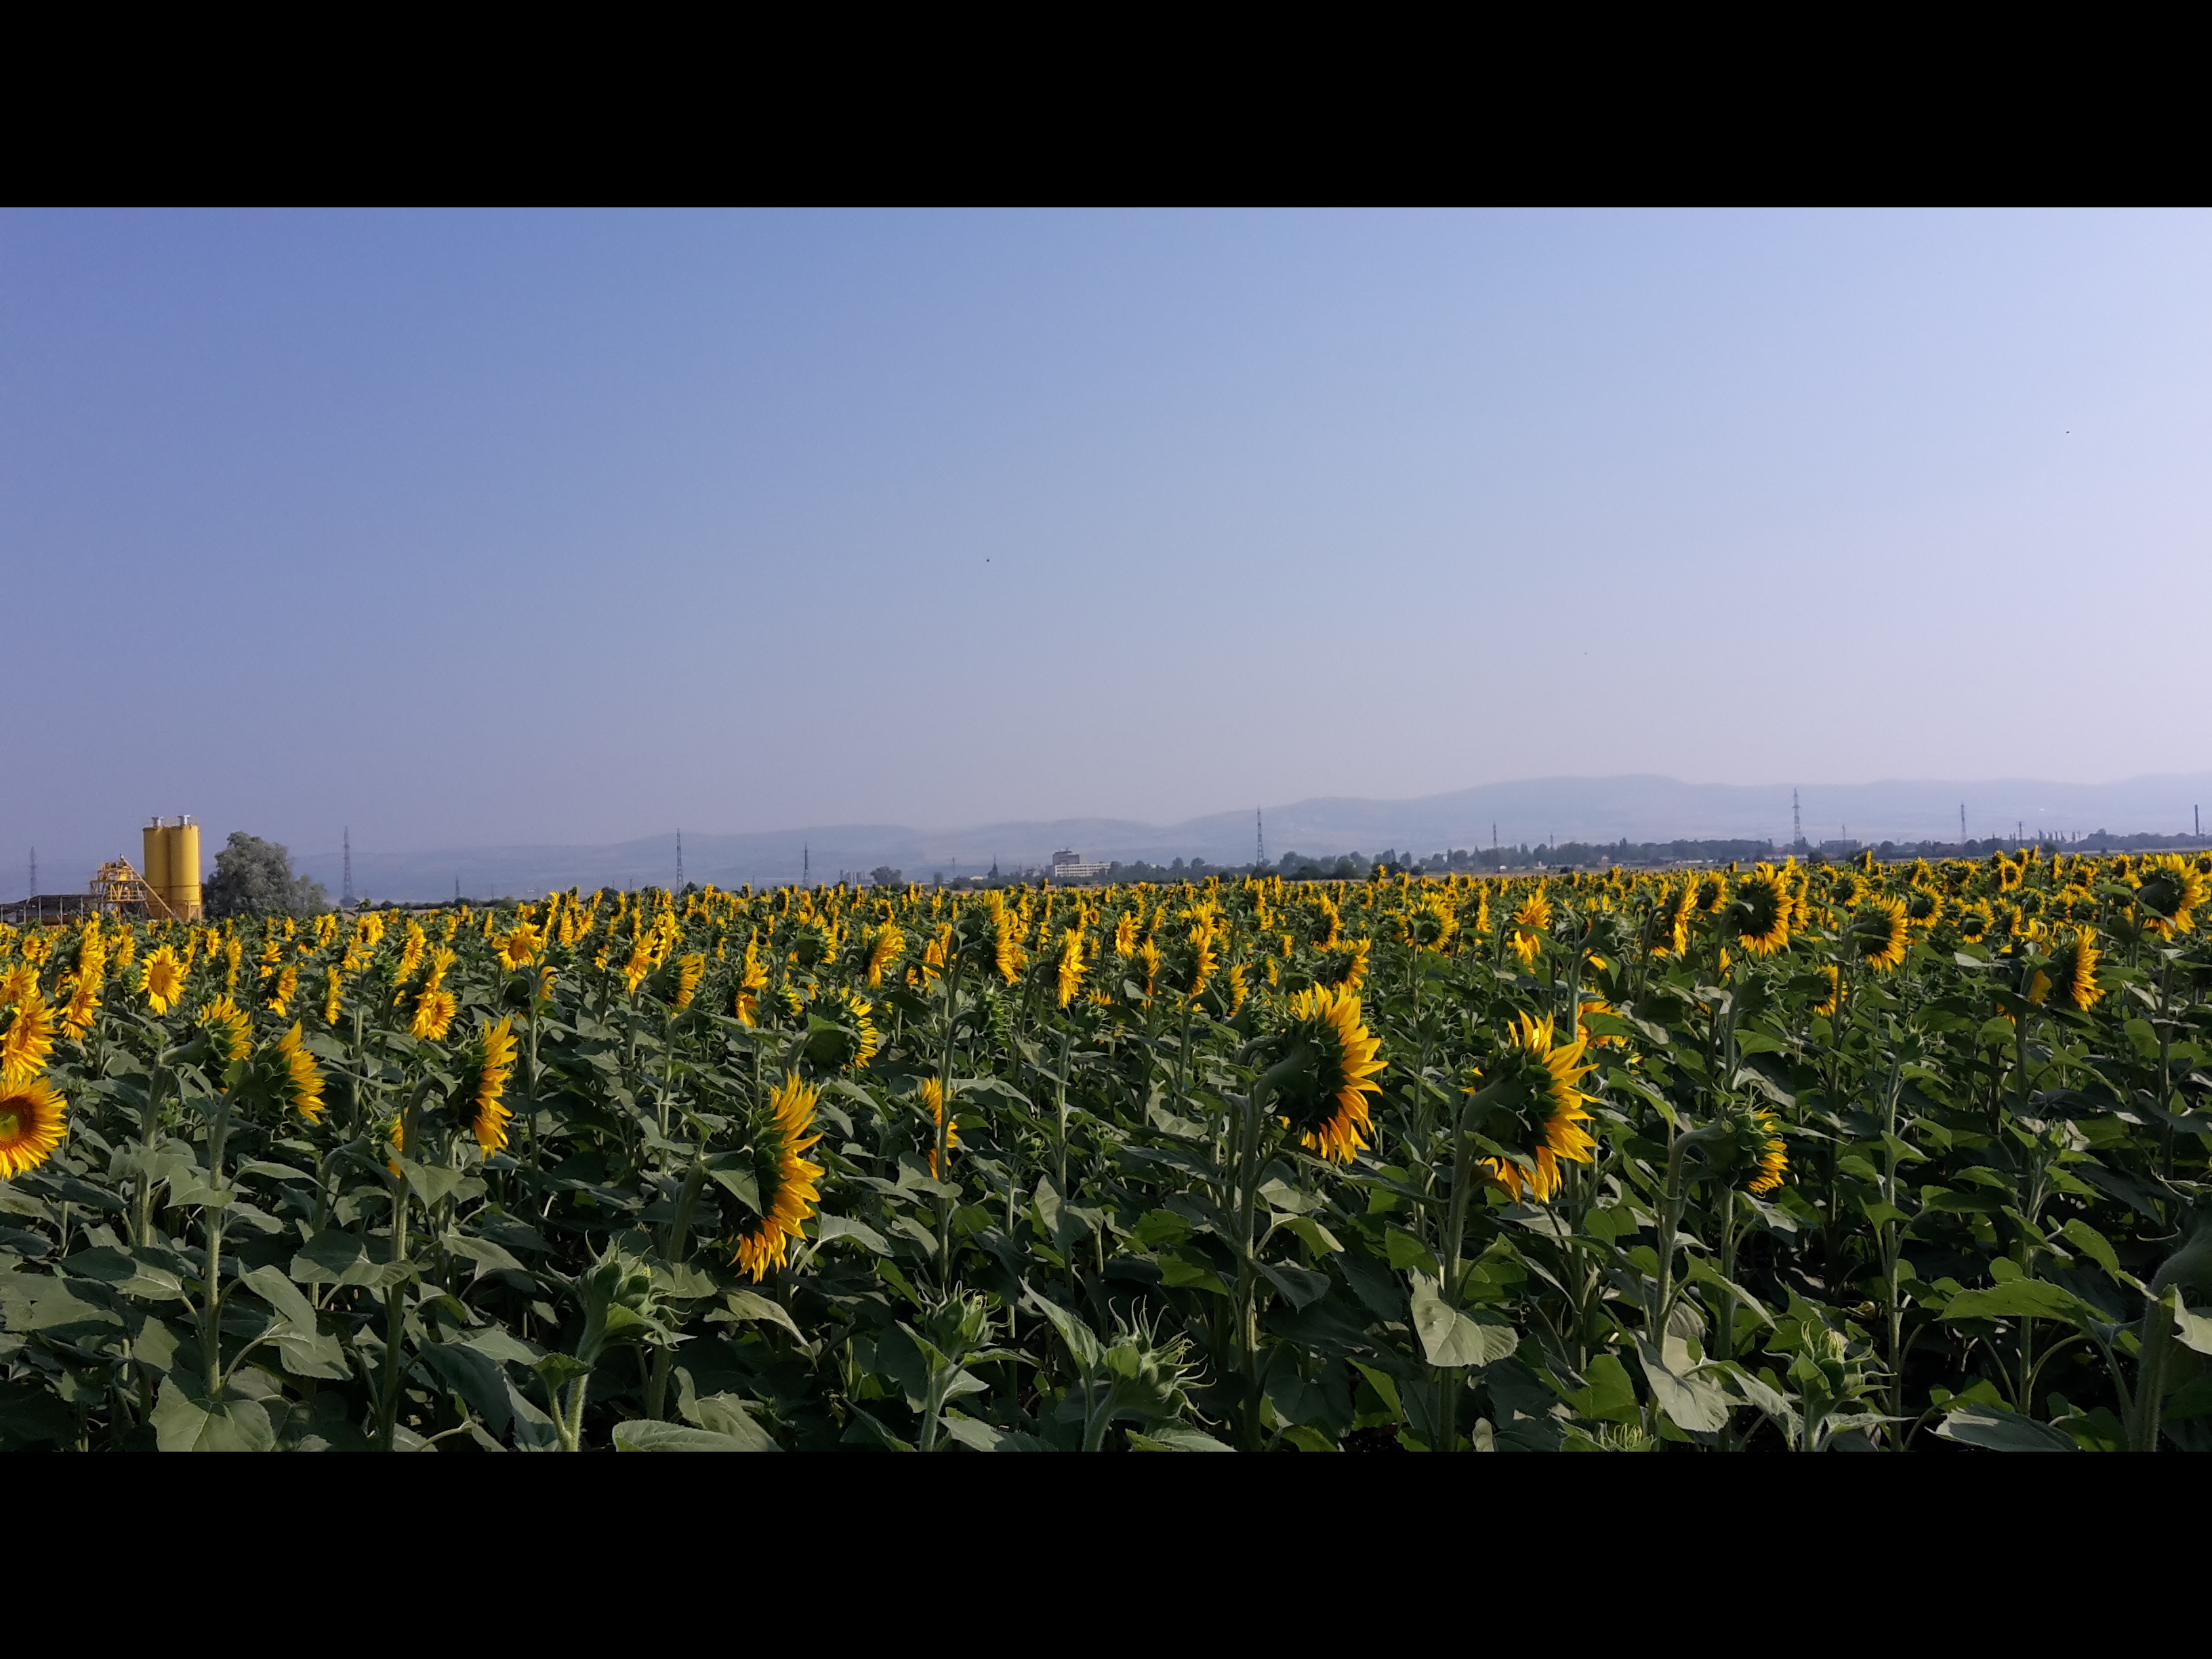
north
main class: Cropland
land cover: Sunflower
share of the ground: > 75 %
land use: Agriculture (excluding fallow land and kitchen gardens)
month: July
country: BG
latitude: 42.7731
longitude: 23.1962
